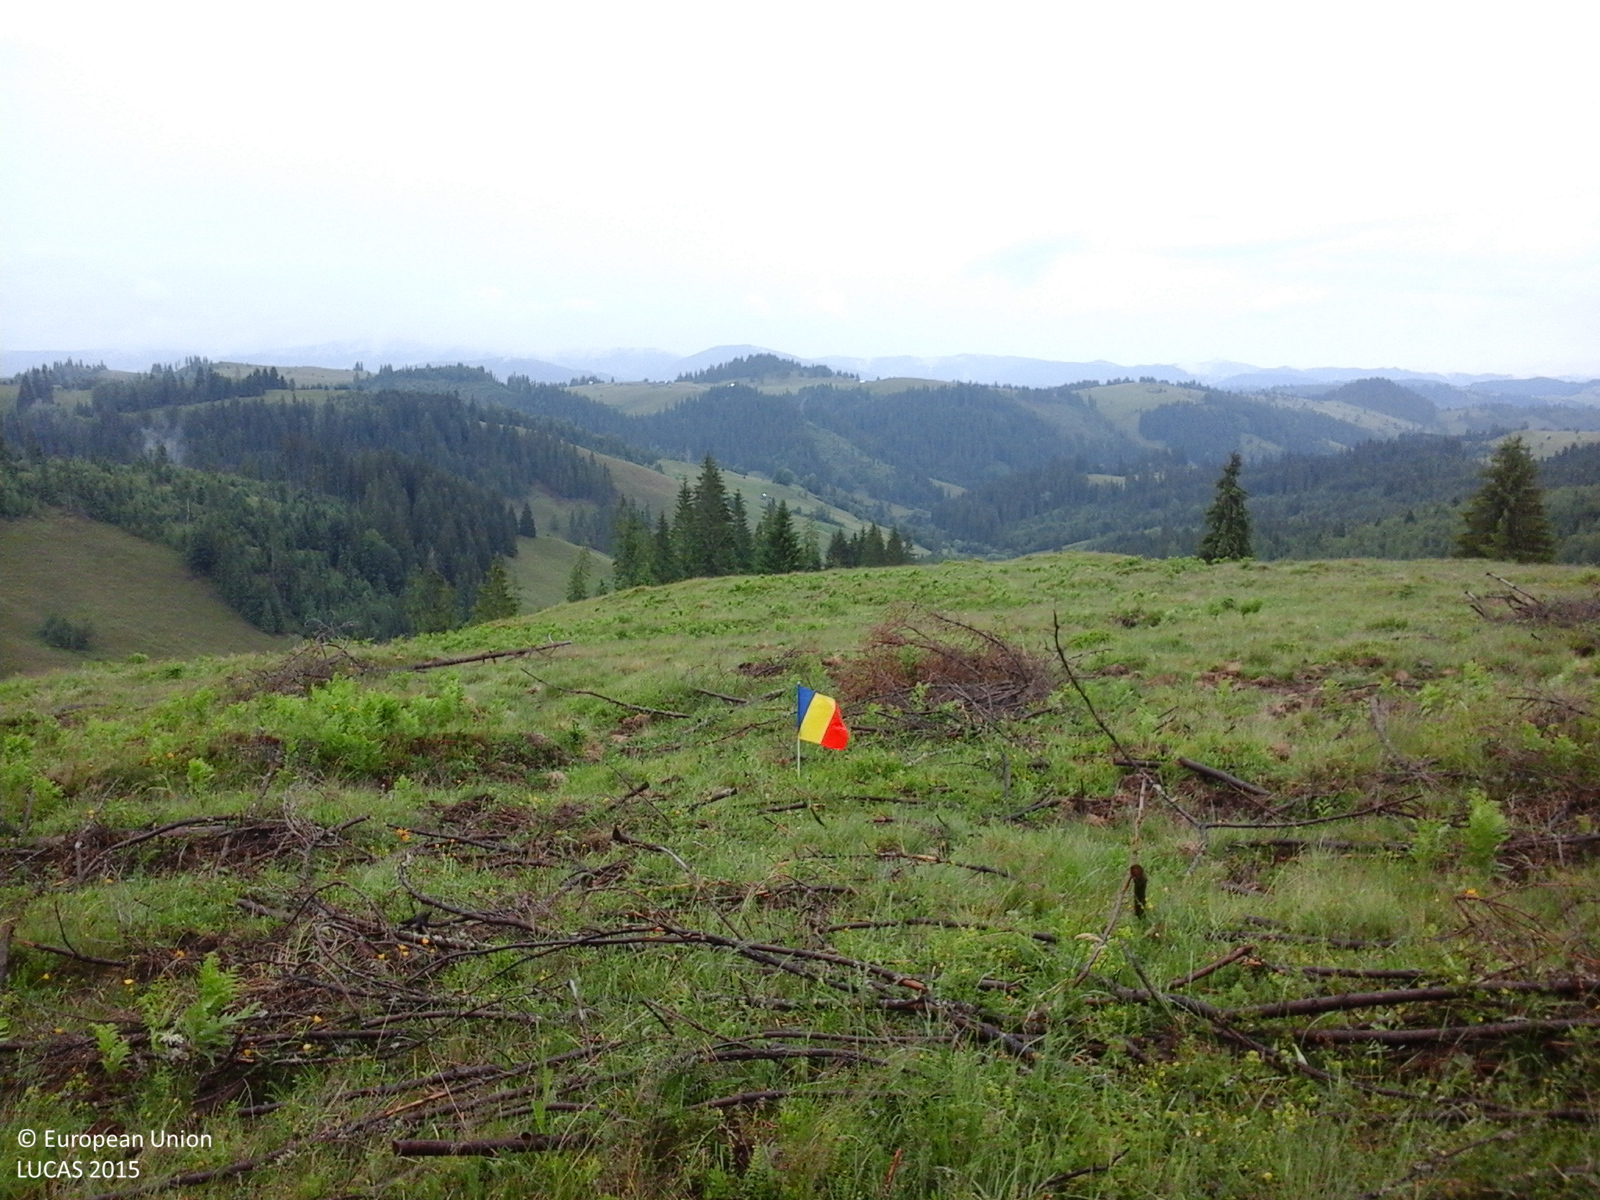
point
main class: Grassland
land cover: Grassland with sparse tree/shrub cover
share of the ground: > 75 %
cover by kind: herbaceous plants 90 %, coniferous forest trees 5 %, shrubs 5 %
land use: Agriculture (excluding fallow land and kitchen gardens)
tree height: < 5 m
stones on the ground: 25 - 50 %
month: June
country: RO
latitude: 47.5927
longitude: 25.2580
